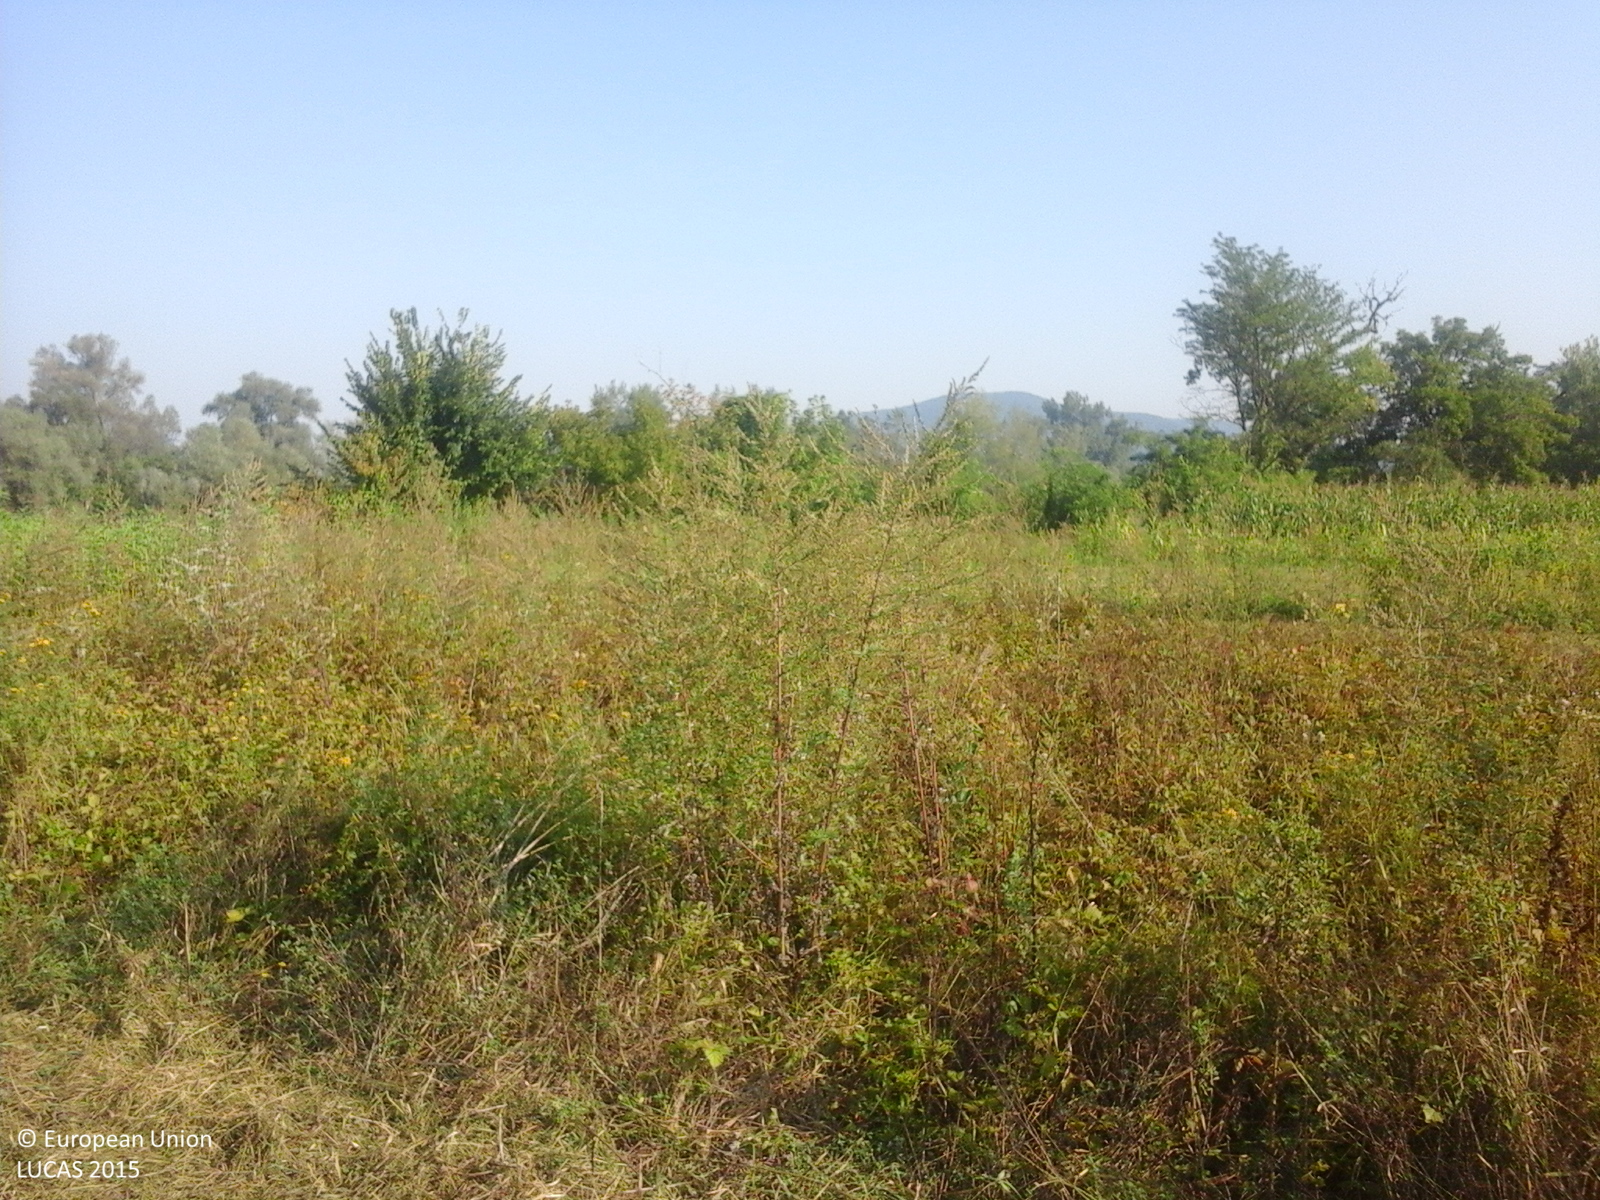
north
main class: Grassland
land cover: Grassland without tree/shrub cover
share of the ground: > 75 %
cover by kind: herbaceous plants 100 %
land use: Agriculture (excluding fallow land and kitchen gardens)
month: August
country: RO
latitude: 45.9875
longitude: 22.4276
